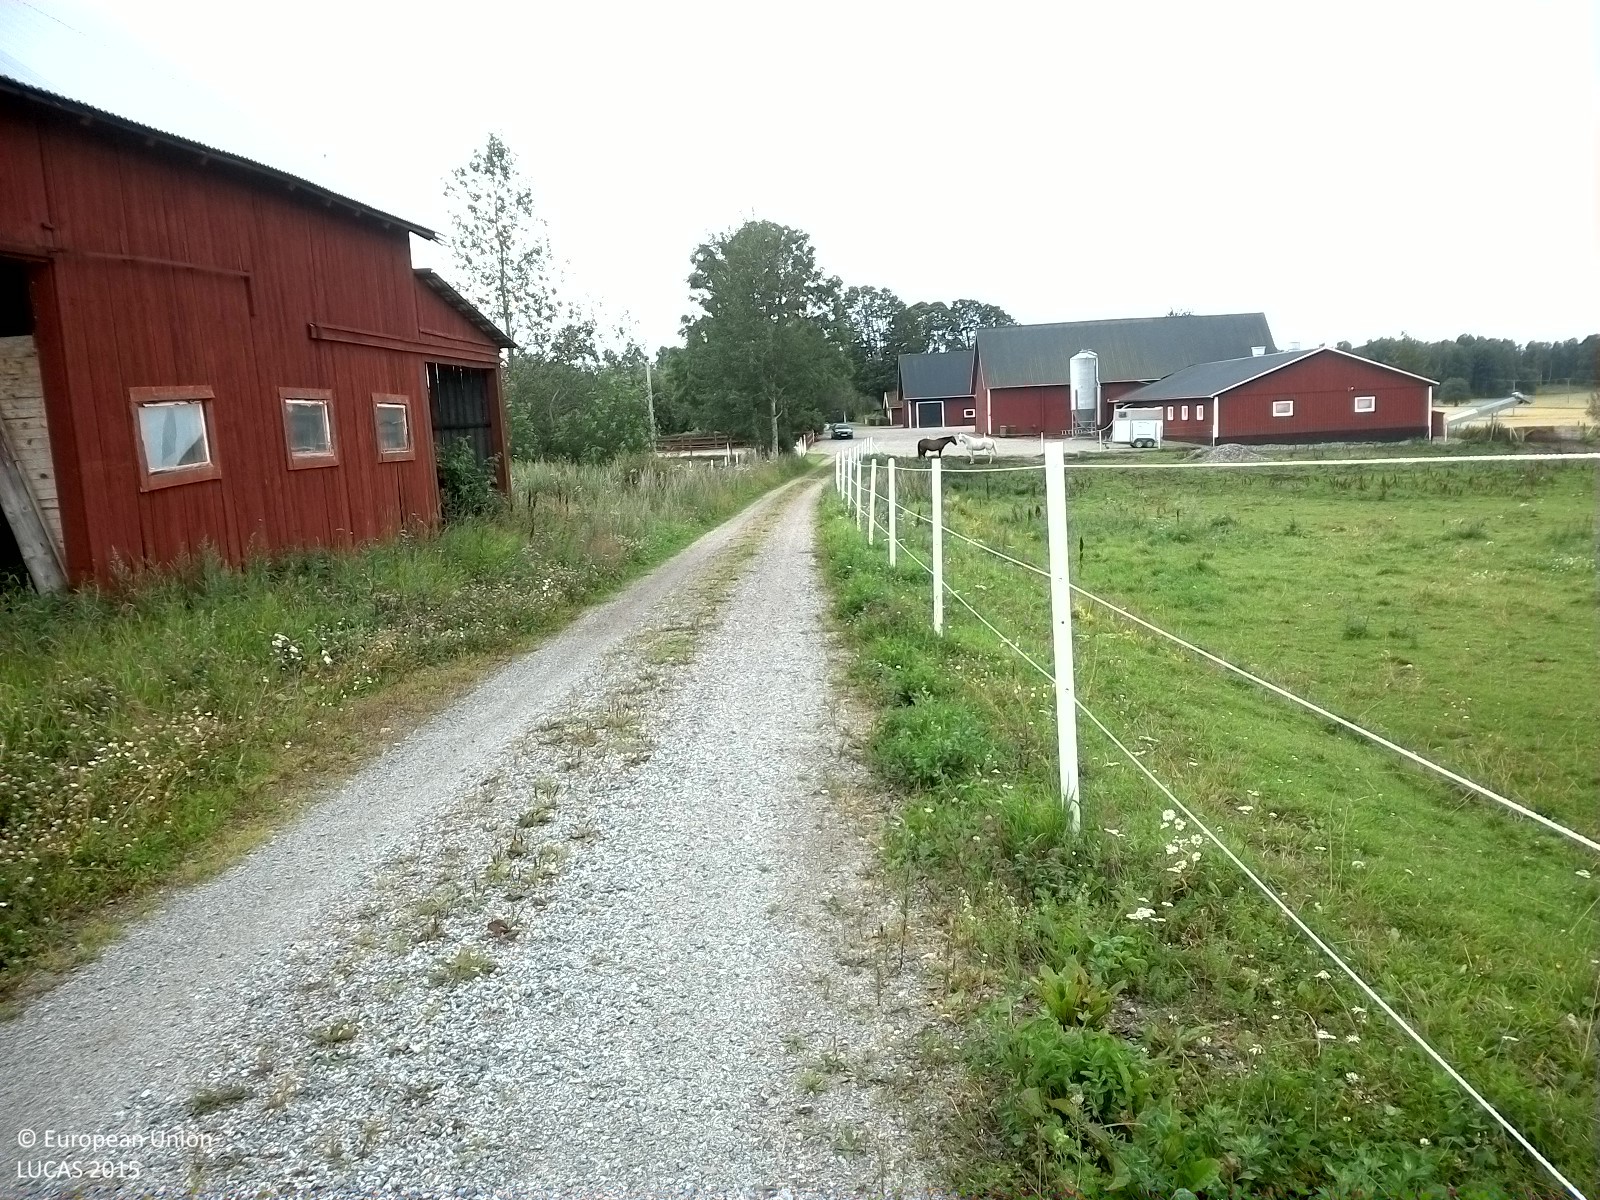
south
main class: Grassland
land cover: Grassland without tree/shrub cover
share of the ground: > 75 %
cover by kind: herbaceous plants 100 %
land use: Agriculture (excluding fallow land and kitchen gardens)
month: August
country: SE
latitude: 59.0808
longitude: 15.0347
